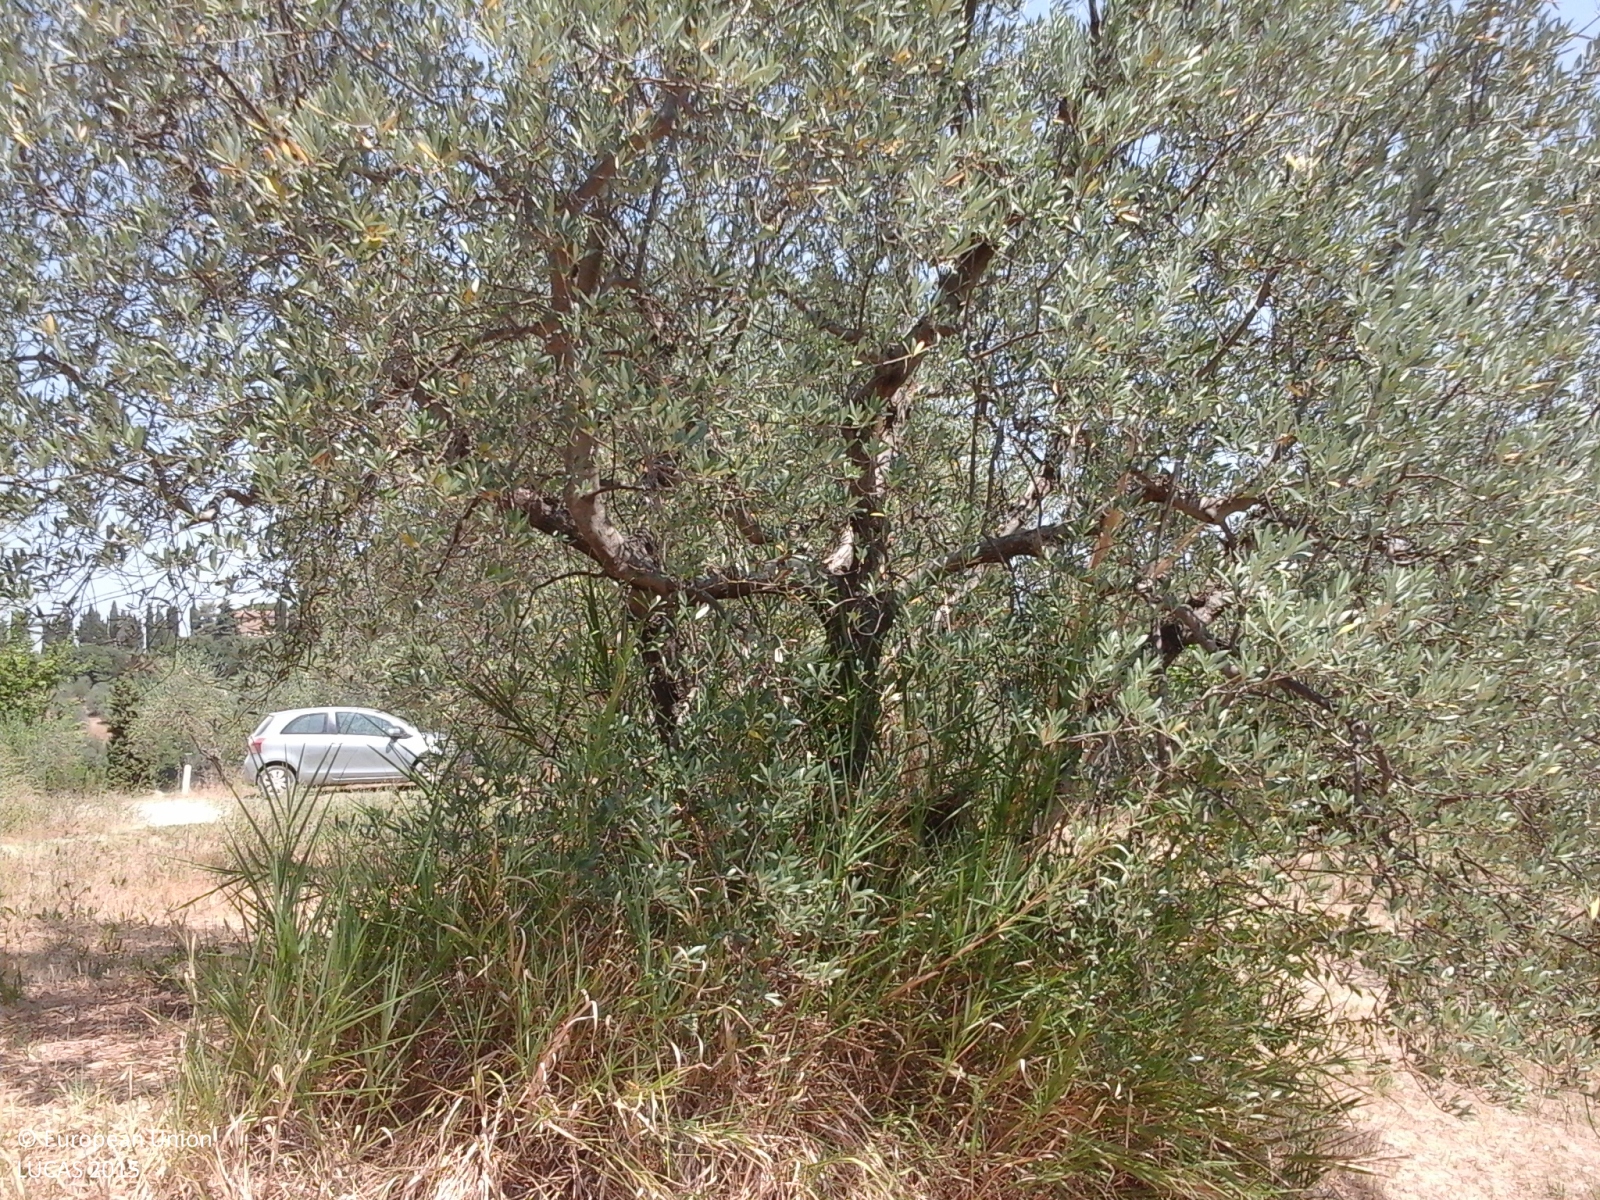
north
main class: Grassland
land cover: Grassland with sparse tree/shrub cover
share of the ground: > 75 %
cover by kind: herbaceous plants 90 %, broadleaved forest trees 5 %, shrubs 5 %
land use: Semi-natural and natural areas not in use
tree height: < 5 m
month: July
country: IT
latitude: 43.4269
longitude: 10.8499
